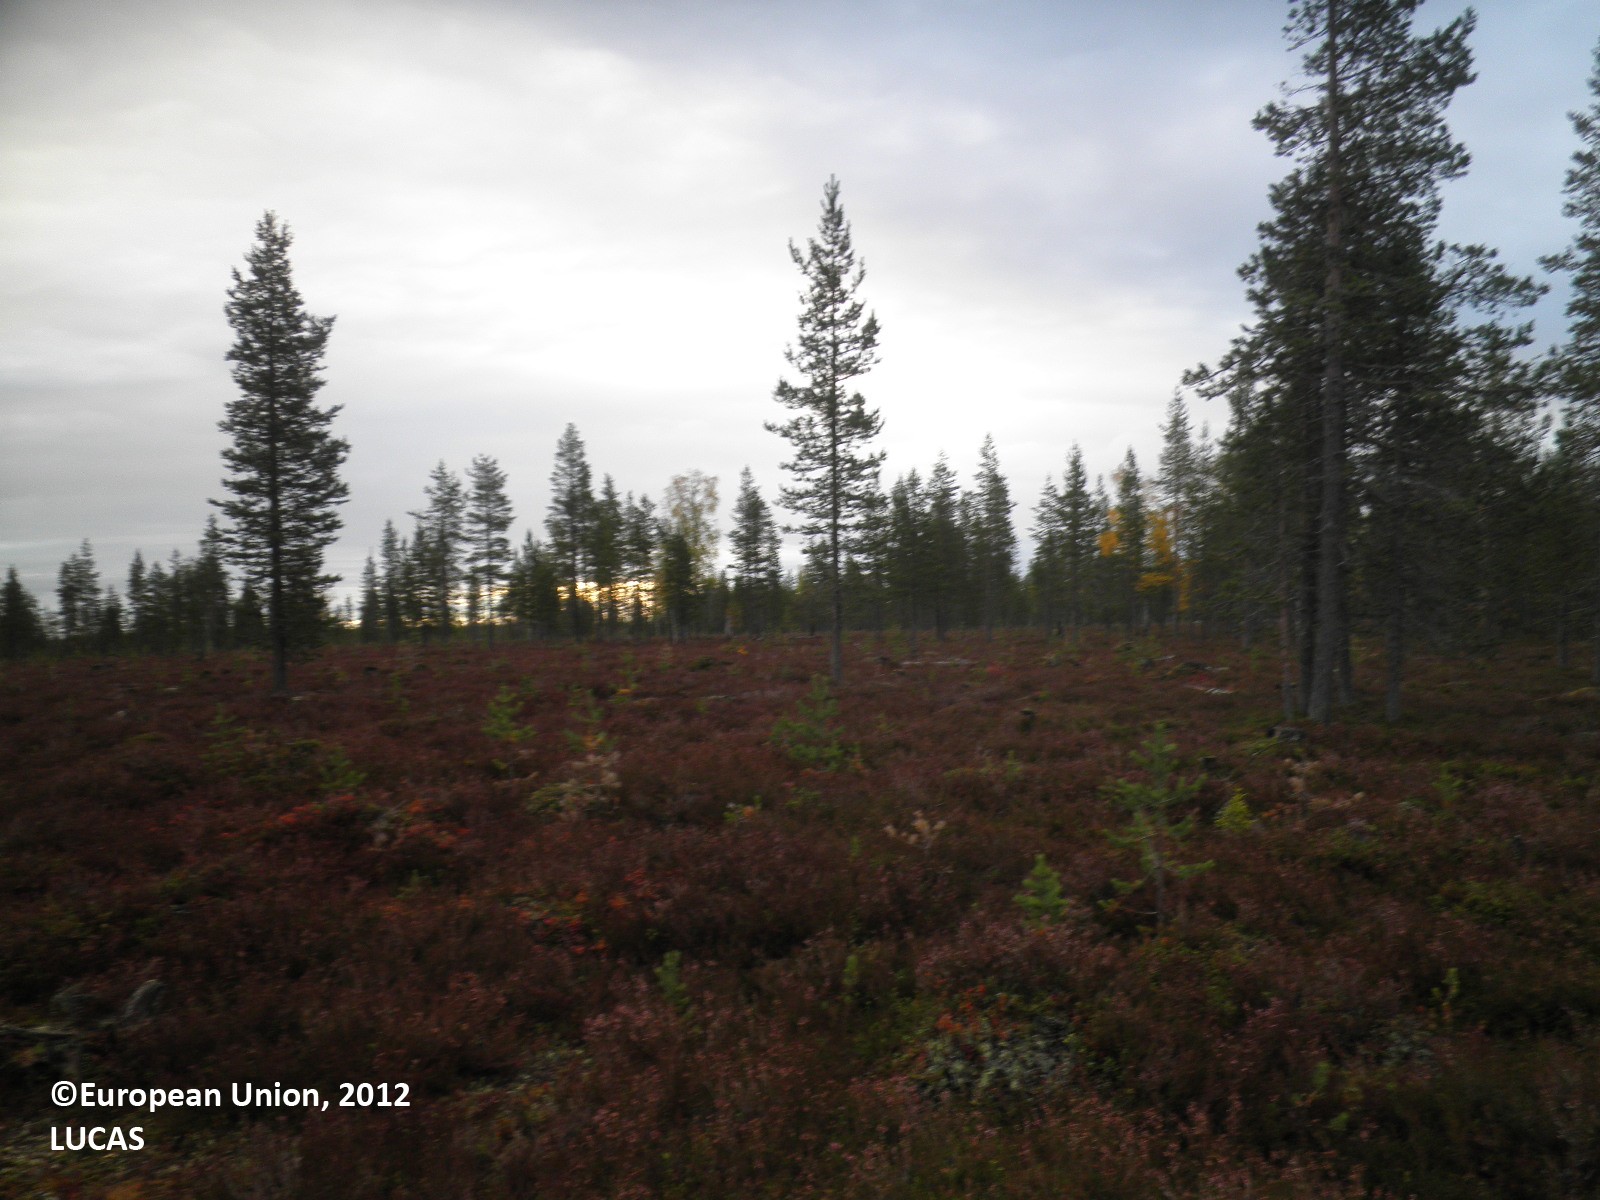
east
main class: Shrubland
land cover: Shrubland with sparse tree cover
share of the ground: > 75 %
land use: Forestry
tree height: > 5 m
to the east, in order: Shrubland with sparse tree cover; Pine dominated coniferous woodland; Shrubland with sparse tree cover
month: September
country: FI
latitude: 67.7145
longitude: 28.4846
